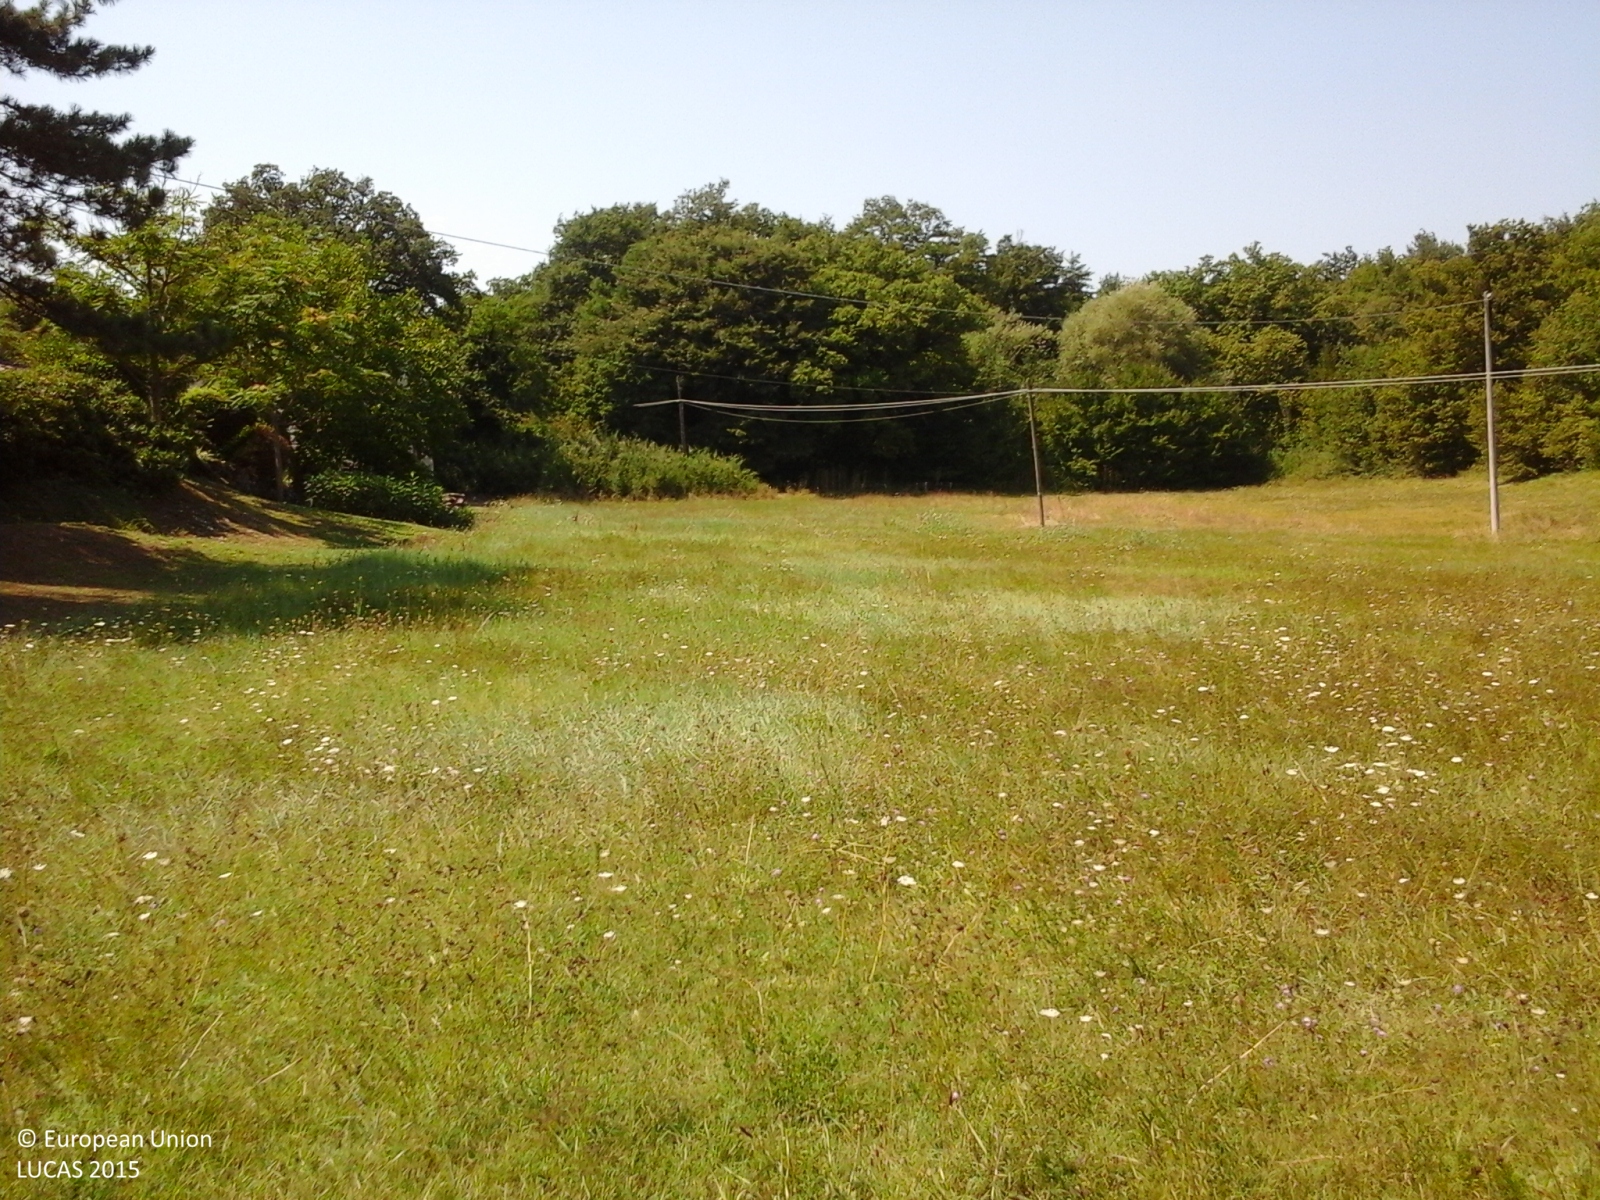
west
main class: Grassland
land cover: Grassland without tree/shrub cover
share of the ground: > 75 %
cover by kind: herbaceous plants 100 %
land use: Agriculture (excluding fallow land and kitchen gardens)
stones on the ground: < 10 %
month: August
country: IT
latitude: 43.7106
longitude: 12.3397
